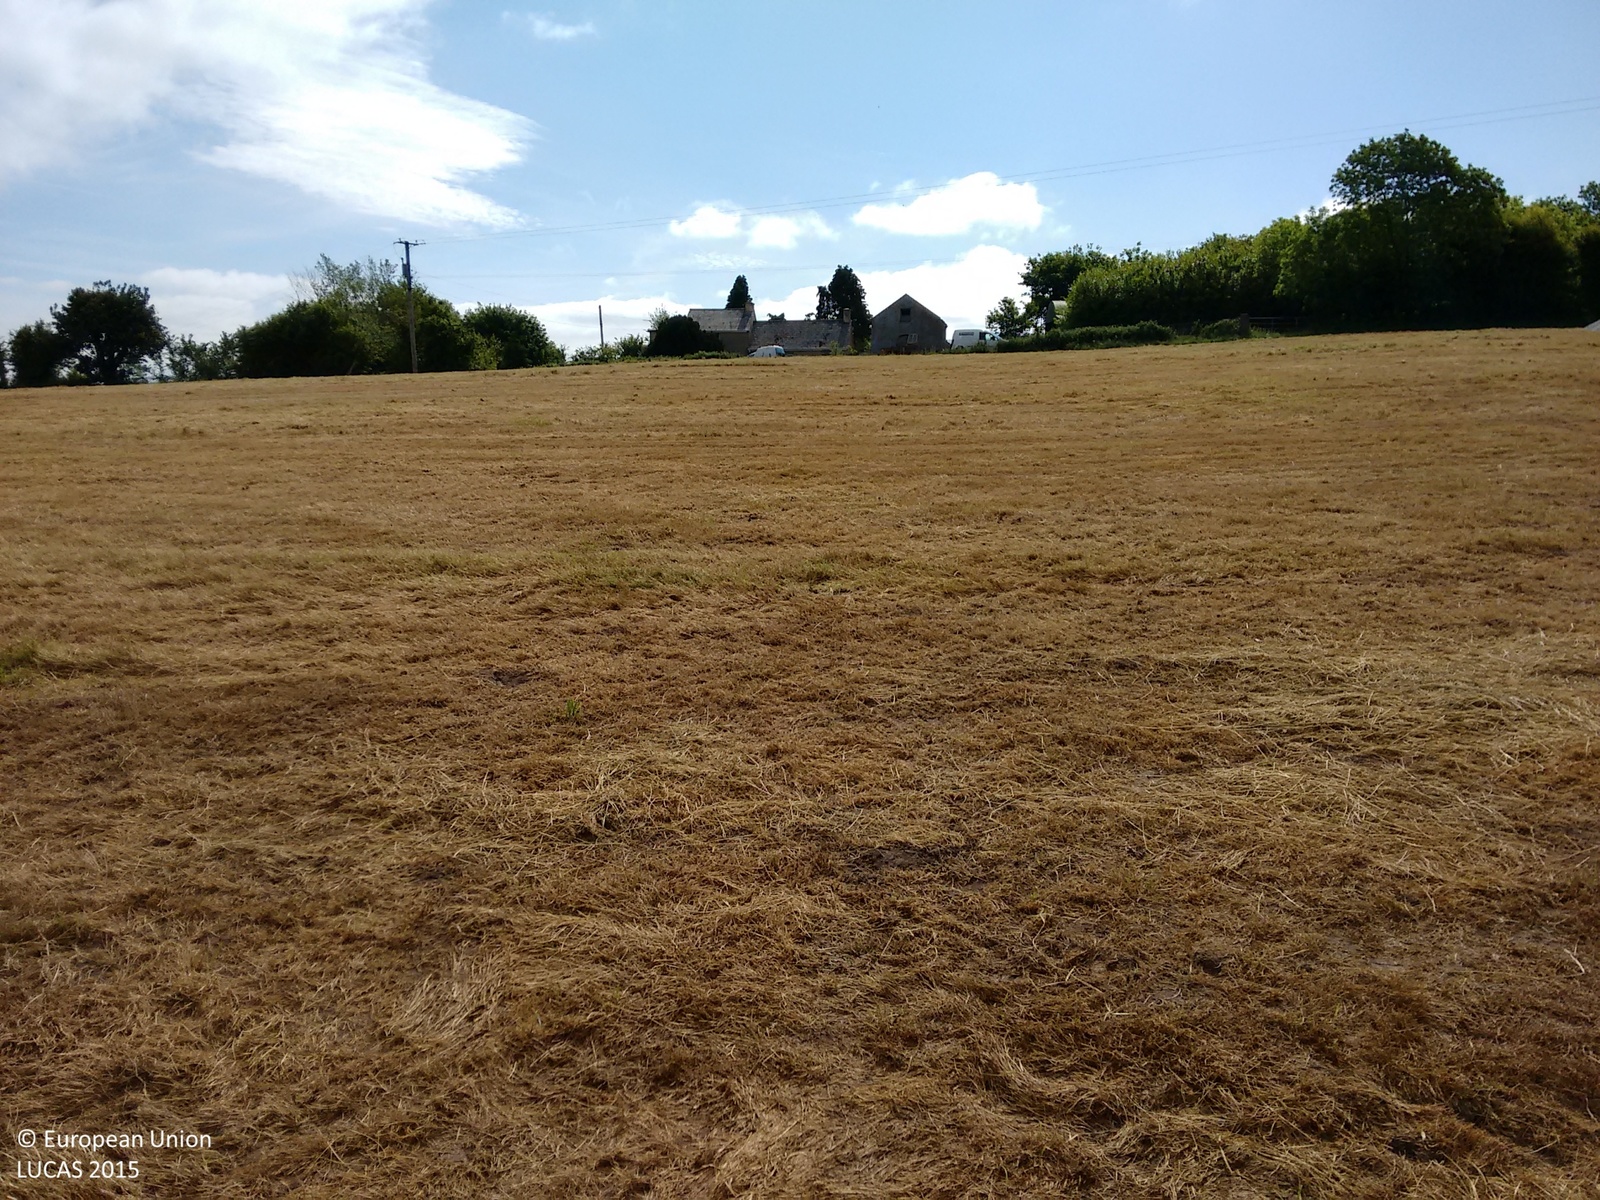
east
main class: Grassland
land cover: Grassland without tree/shrub cover
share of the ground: > 75 %
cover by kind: herbaceous plants 85 %, unconsolidated bare surface 15 %
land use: Agriculture (excluding fallow land and kitchen gardens)
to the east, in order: Grassland without tree/shrub cover; Fences; Grass margins; Artificial constructions in urban areas; Abandoned hedges; Fences; Grassland without tree/shrub cover
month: June
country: IE
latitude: 52.2564
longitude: -8.1265
